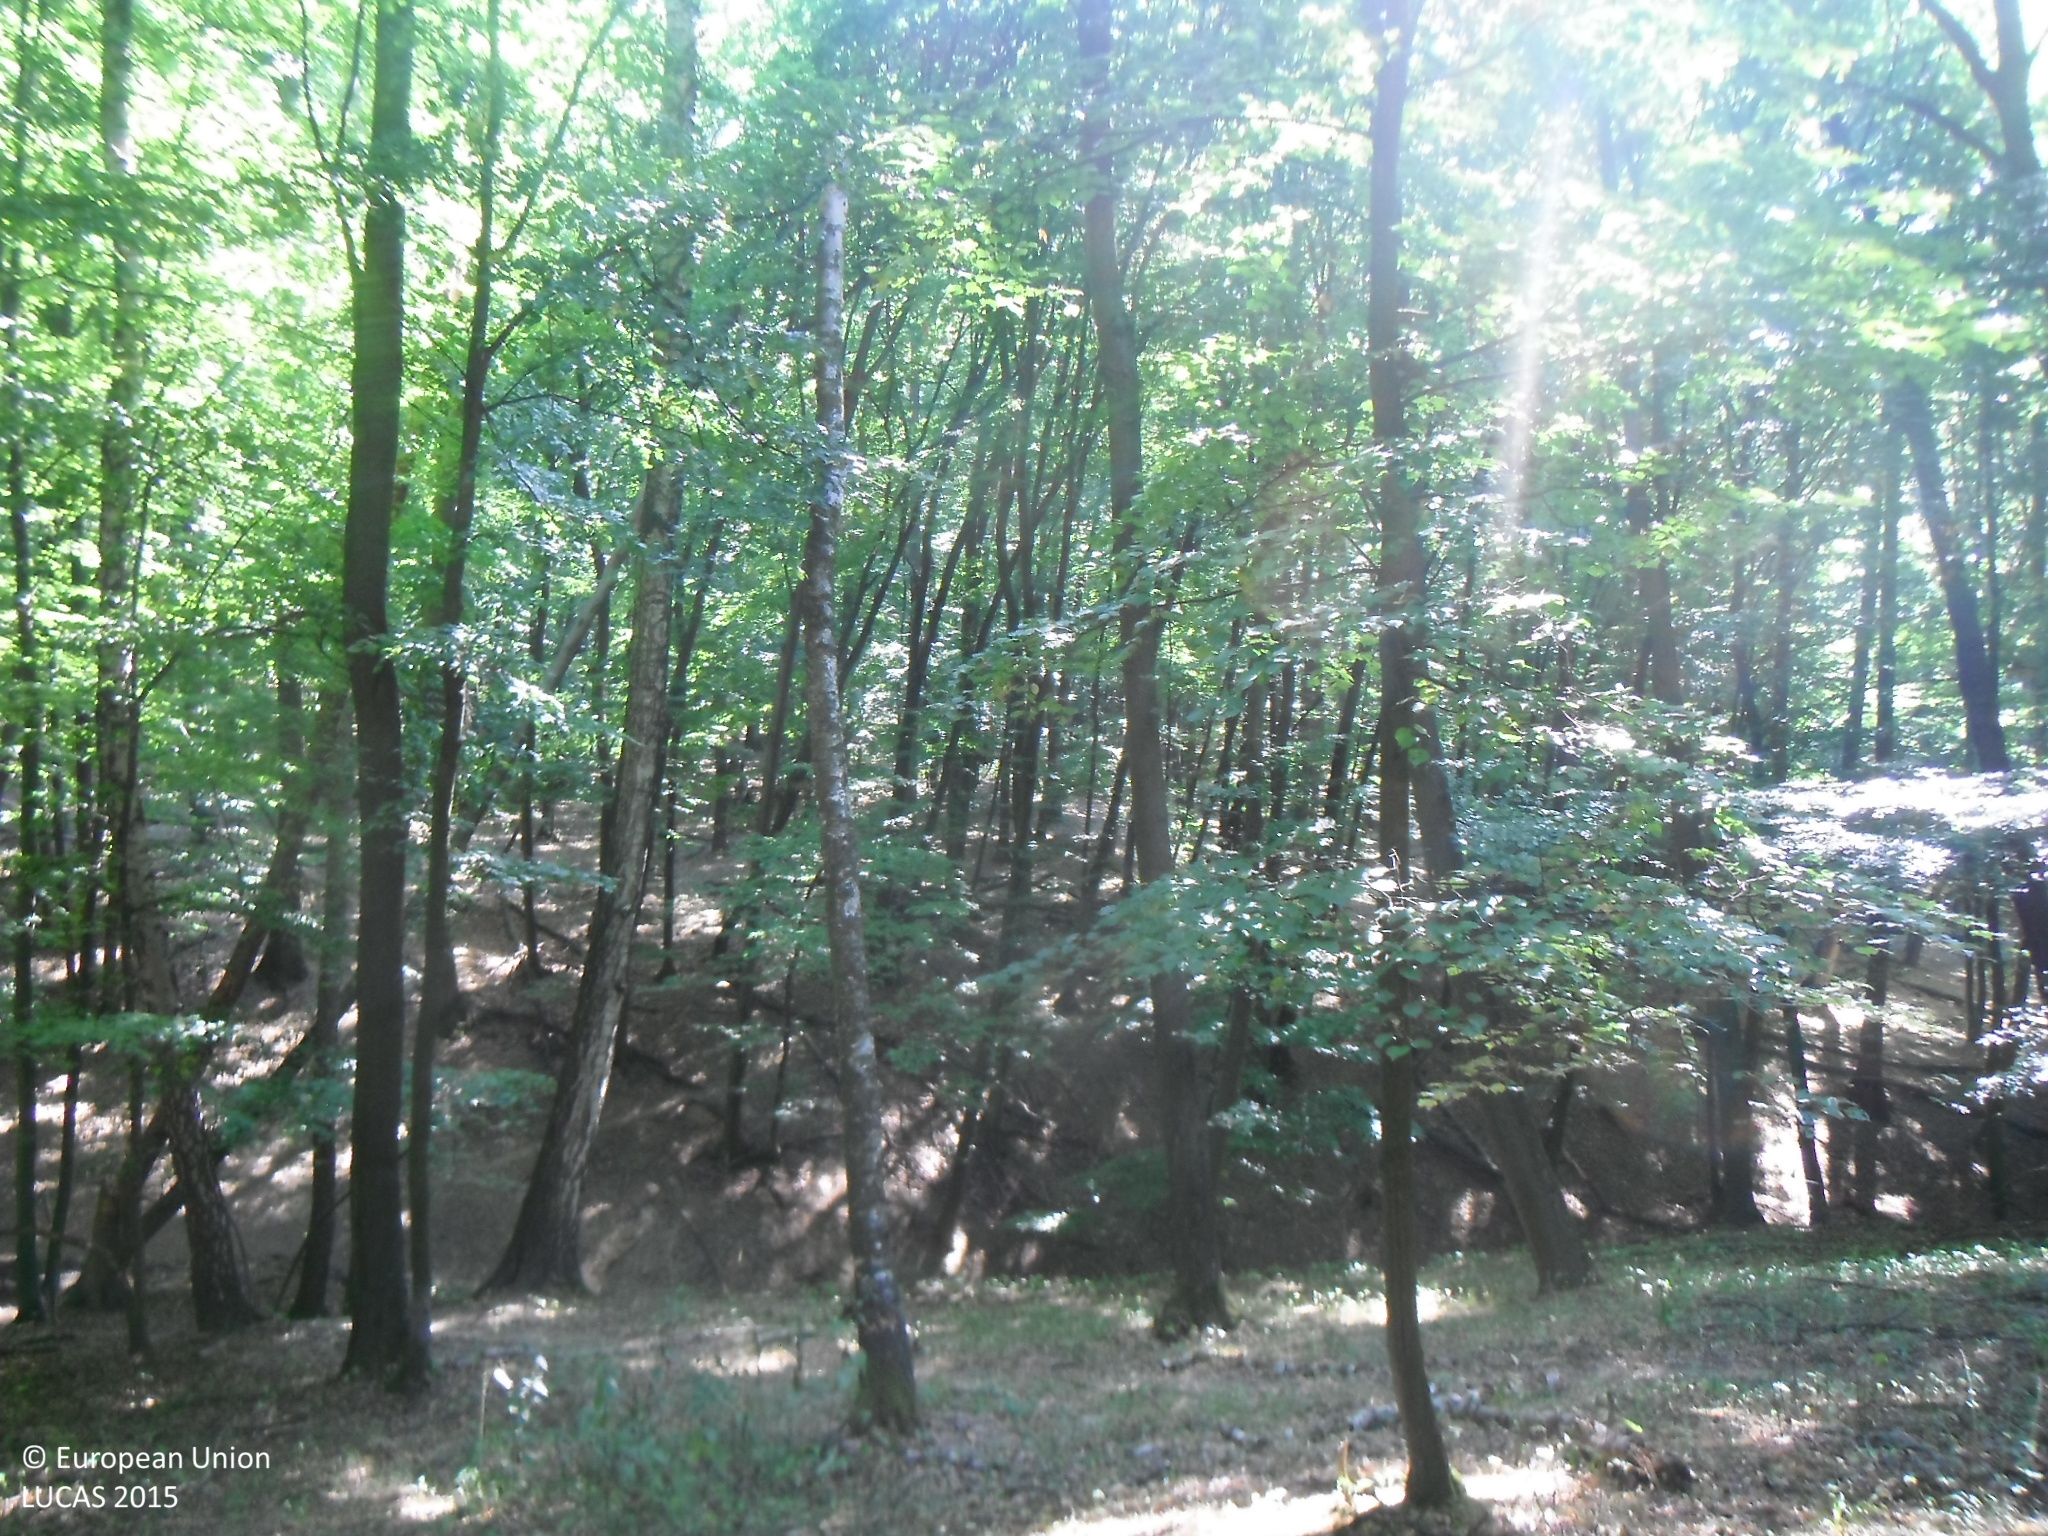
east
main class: Woodland
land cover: Broadleaved woodland
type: mesophytic deciduous forest
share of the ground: > 75 %
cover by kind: broadleaved forest trees 95 %, herbaceous plants 5 %
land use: Forestry
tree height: > 5 m
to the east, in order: Broadleaved woodland; Tracks; Broadleaved woodland
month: July
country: SK
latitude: 48.7250
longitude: 17.2554
